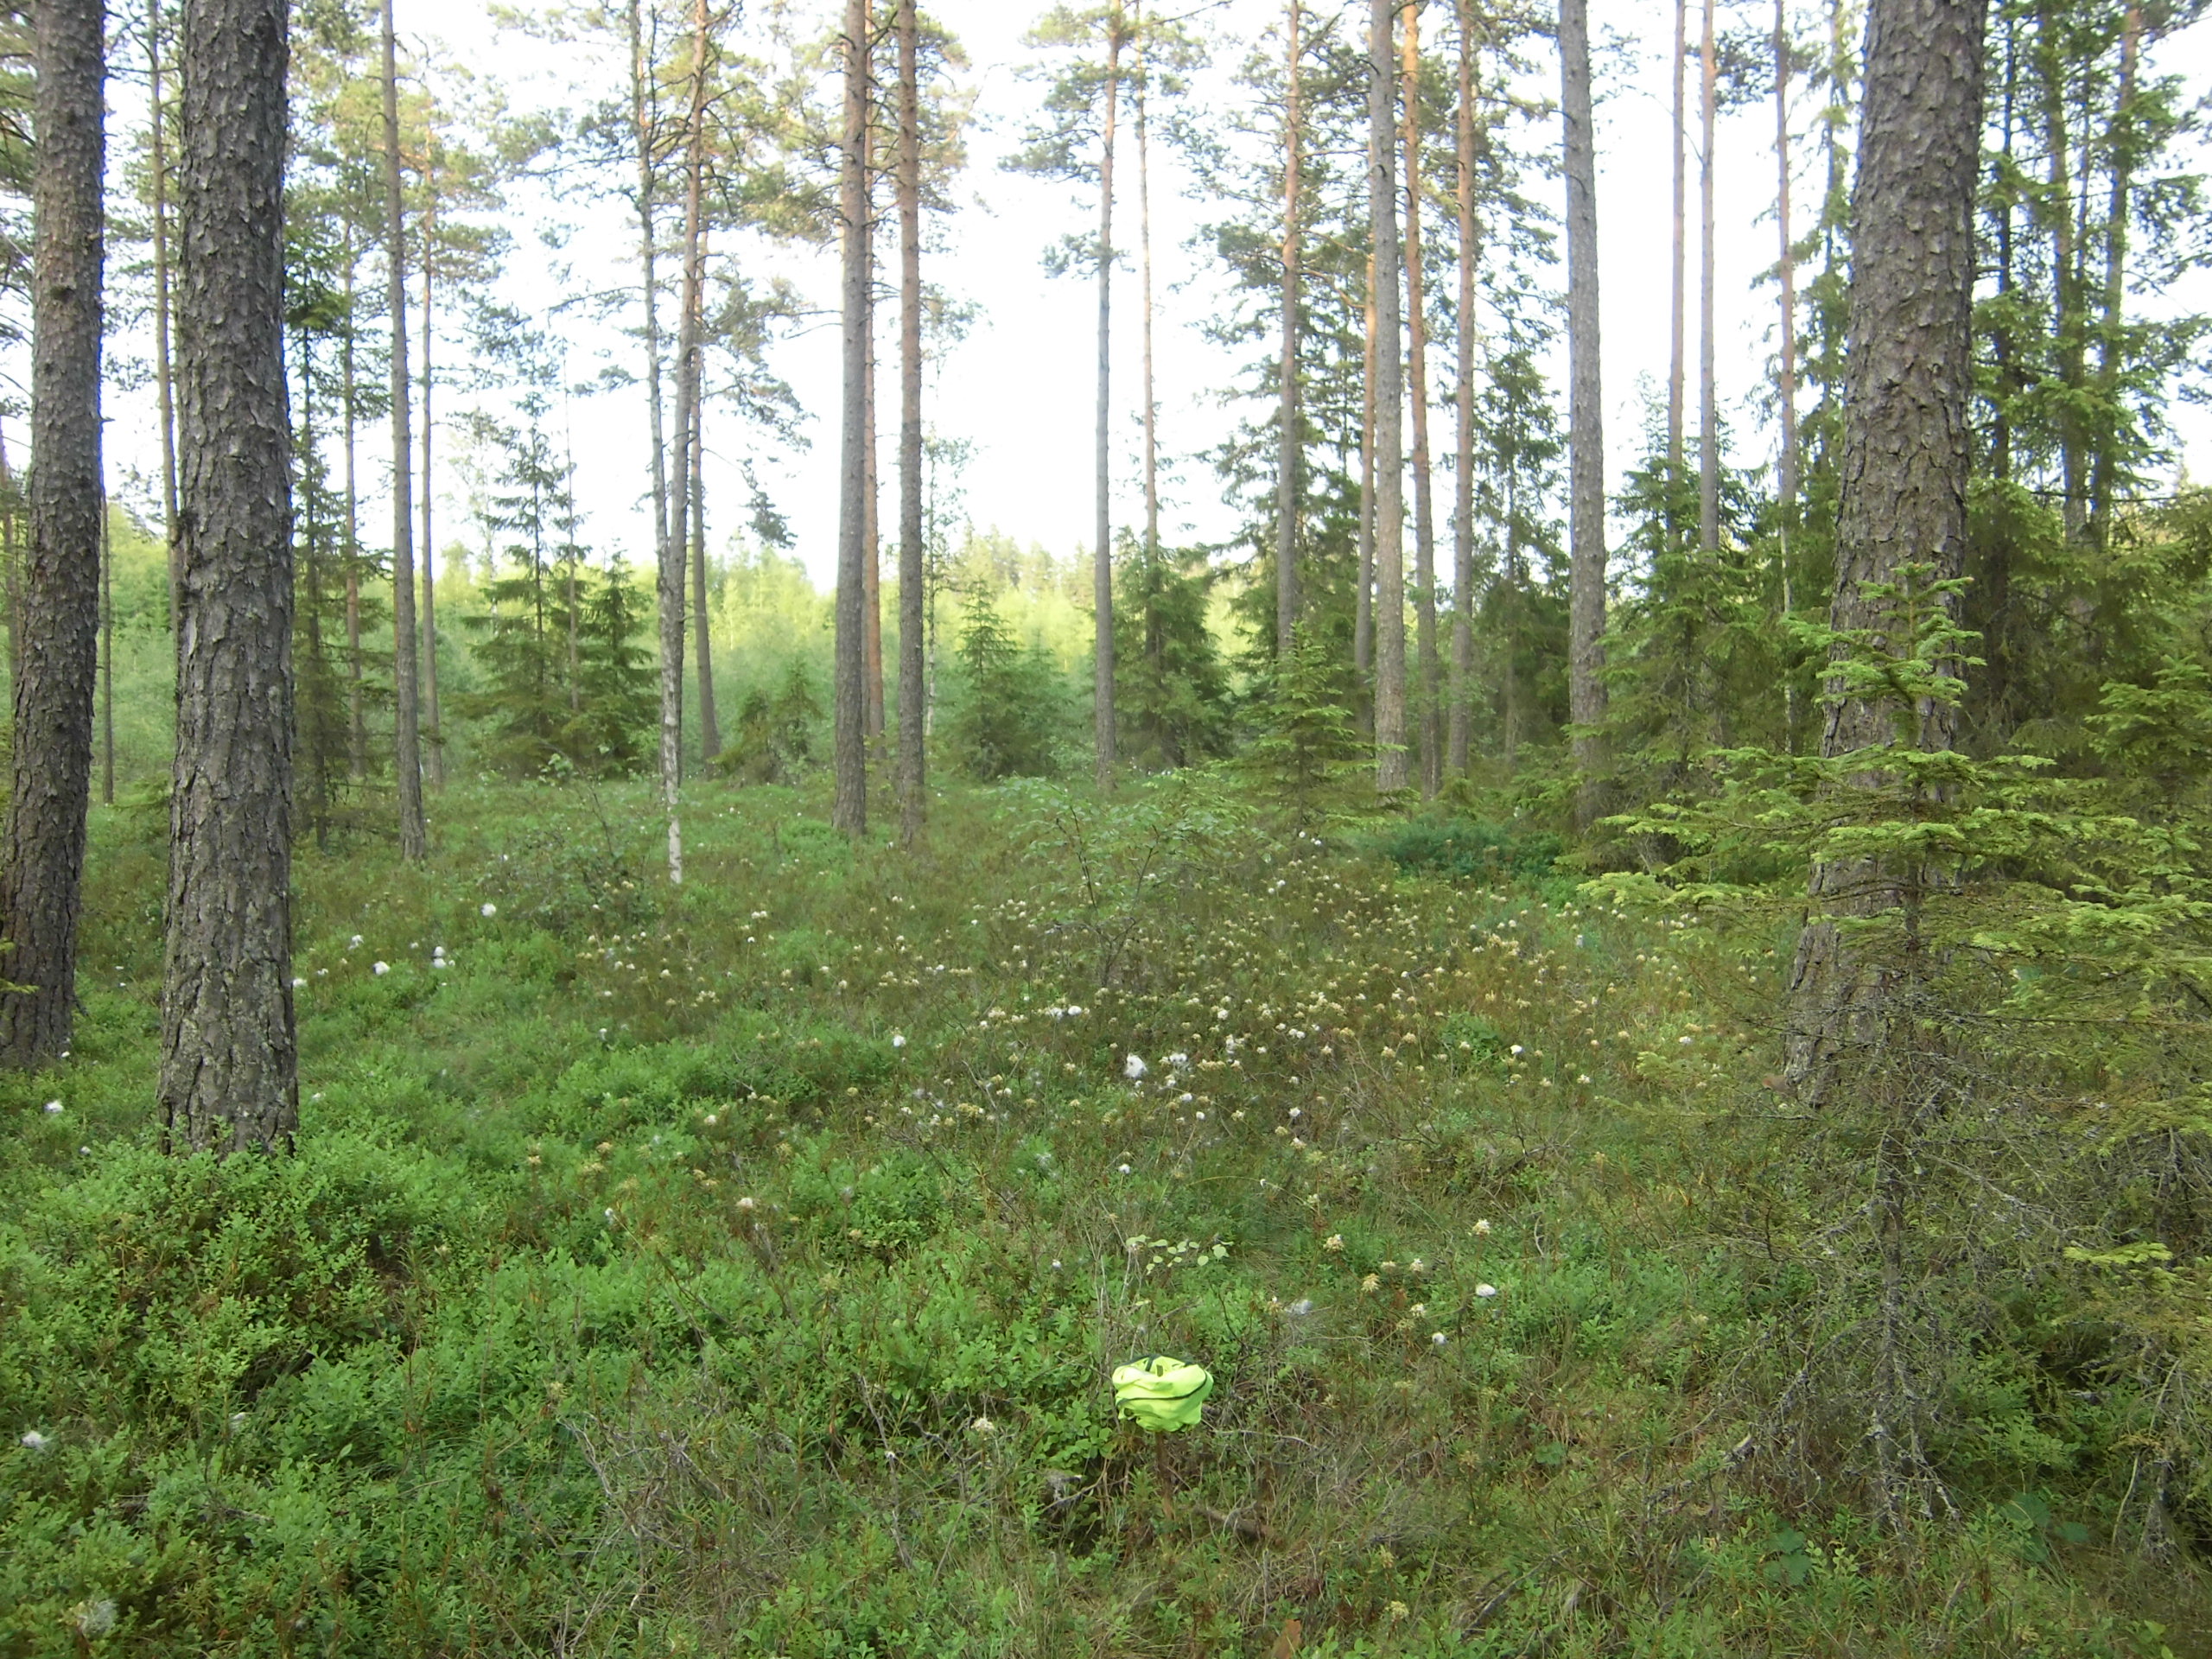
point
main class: Woodland
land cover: Pine dominated coniferous woodland
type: boreal forest
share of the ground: 50 - 75 %
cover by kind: coniferous forest trees 50 %, shrubs 30 %, lichens and mosses 10 %, broadleaved forest trees 5 %, herbaceous plants 5 %
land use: Forestry
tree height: > 5 m
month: July
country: SE
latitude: 57.3052
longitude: 14.7934
